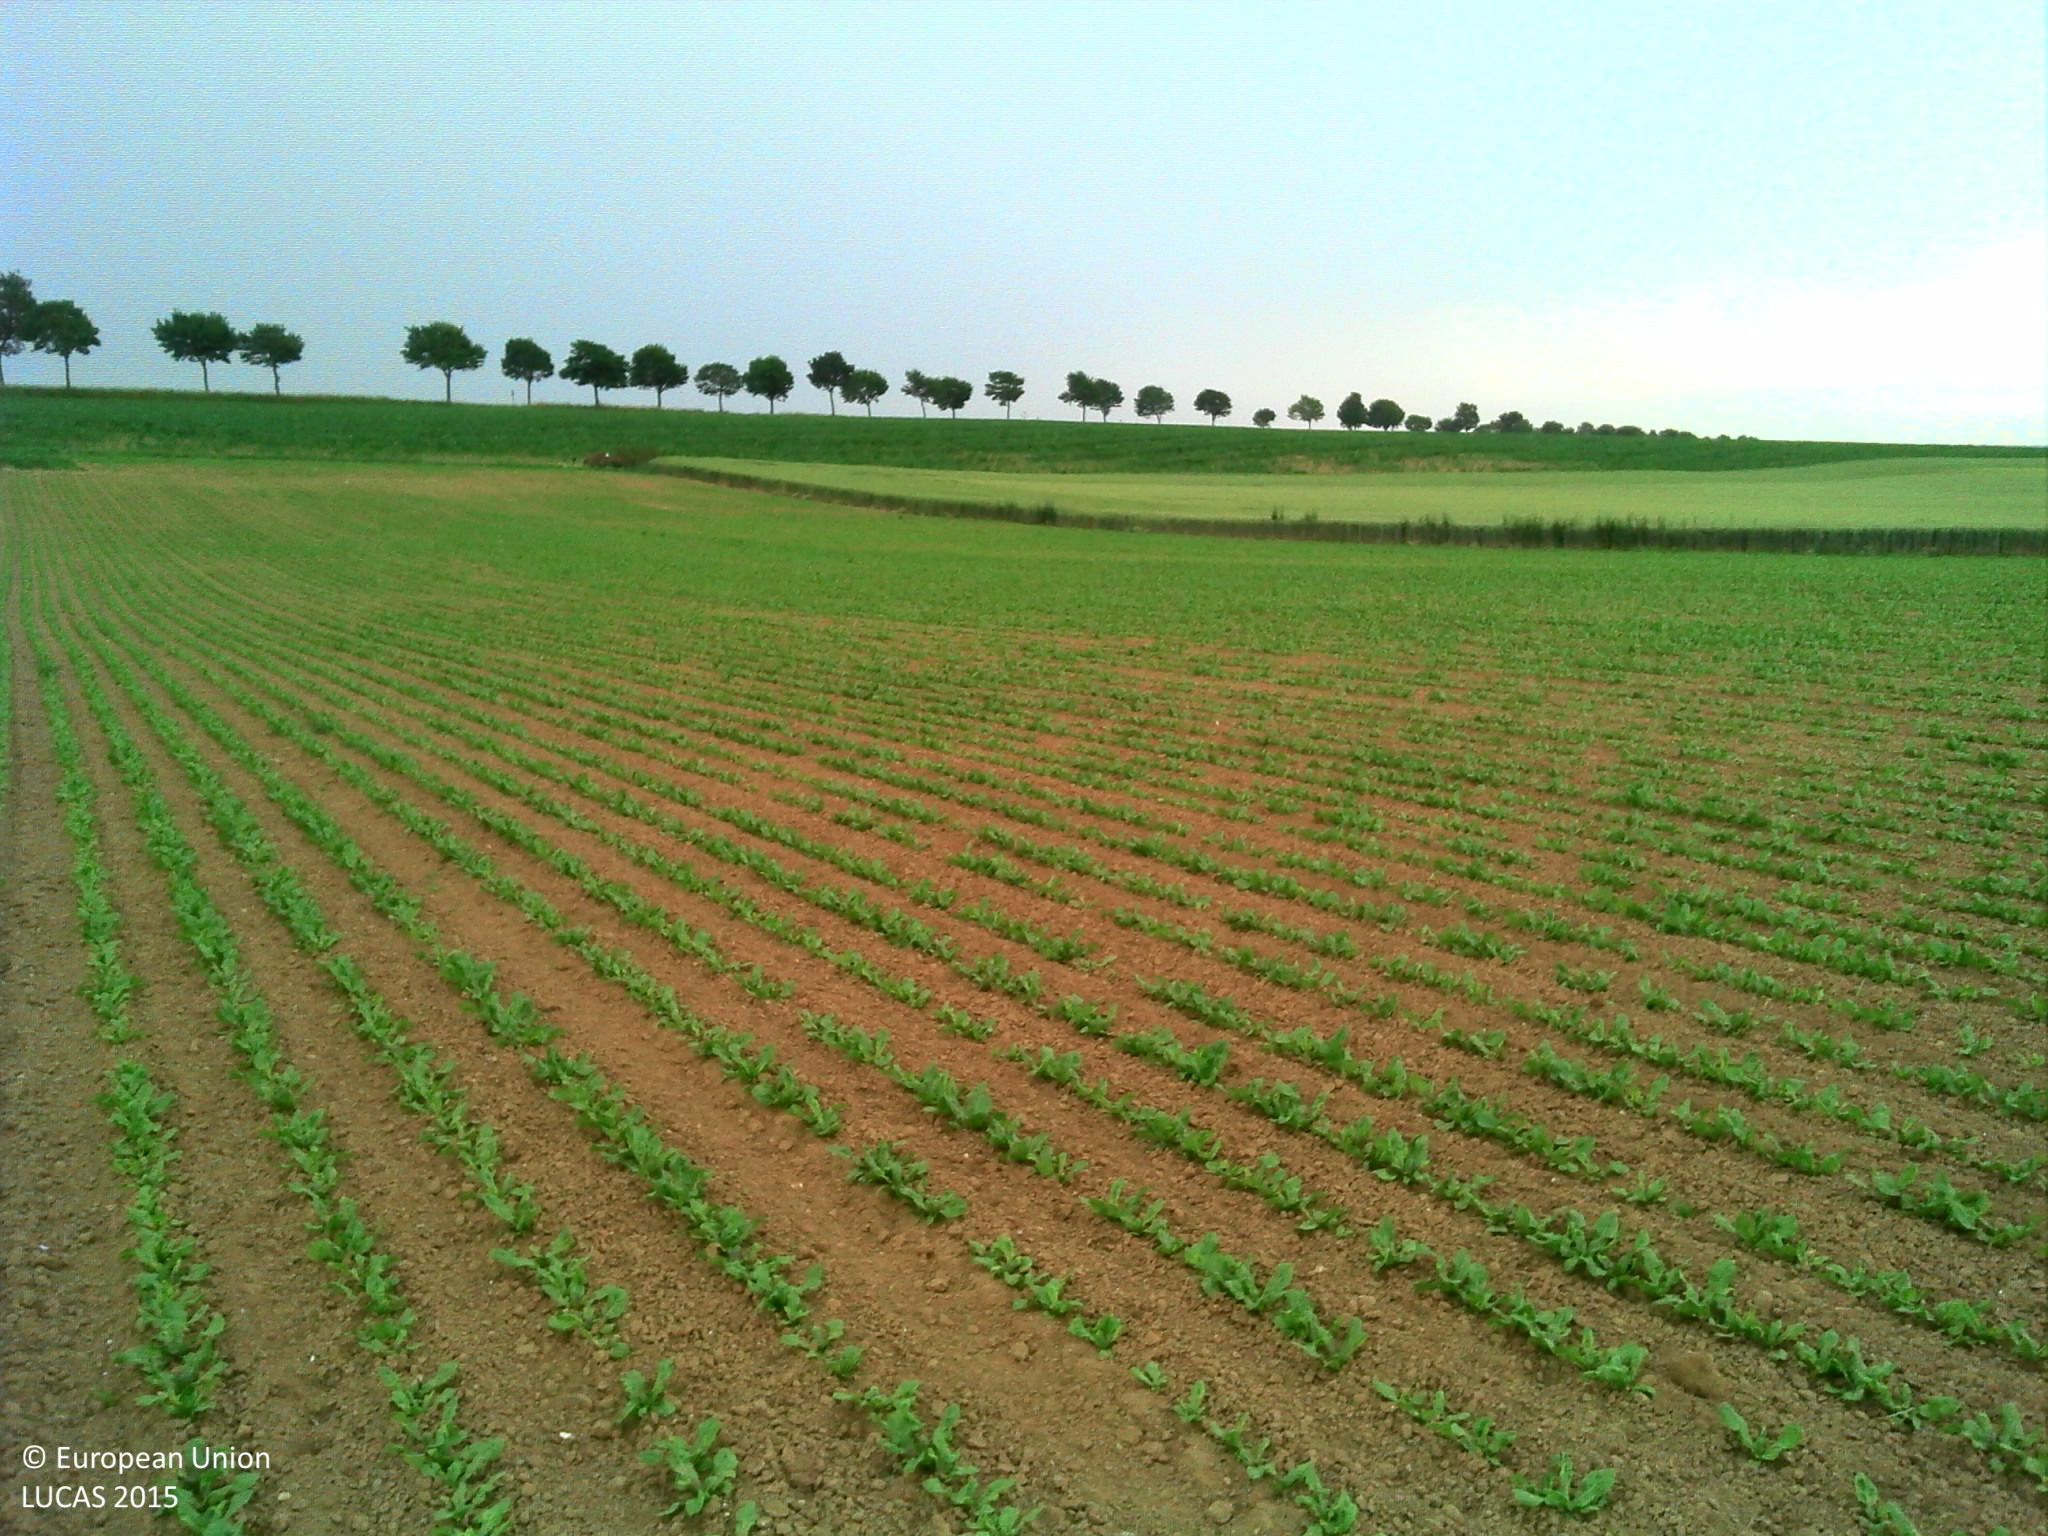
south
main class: Cropland
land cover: Other fresh vegetables
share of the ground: 10 - 25 %
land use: Agriculture (excluding fallow land and kitchen gardens)
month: July
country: FR
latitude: 50.4508
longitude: 2.0839
